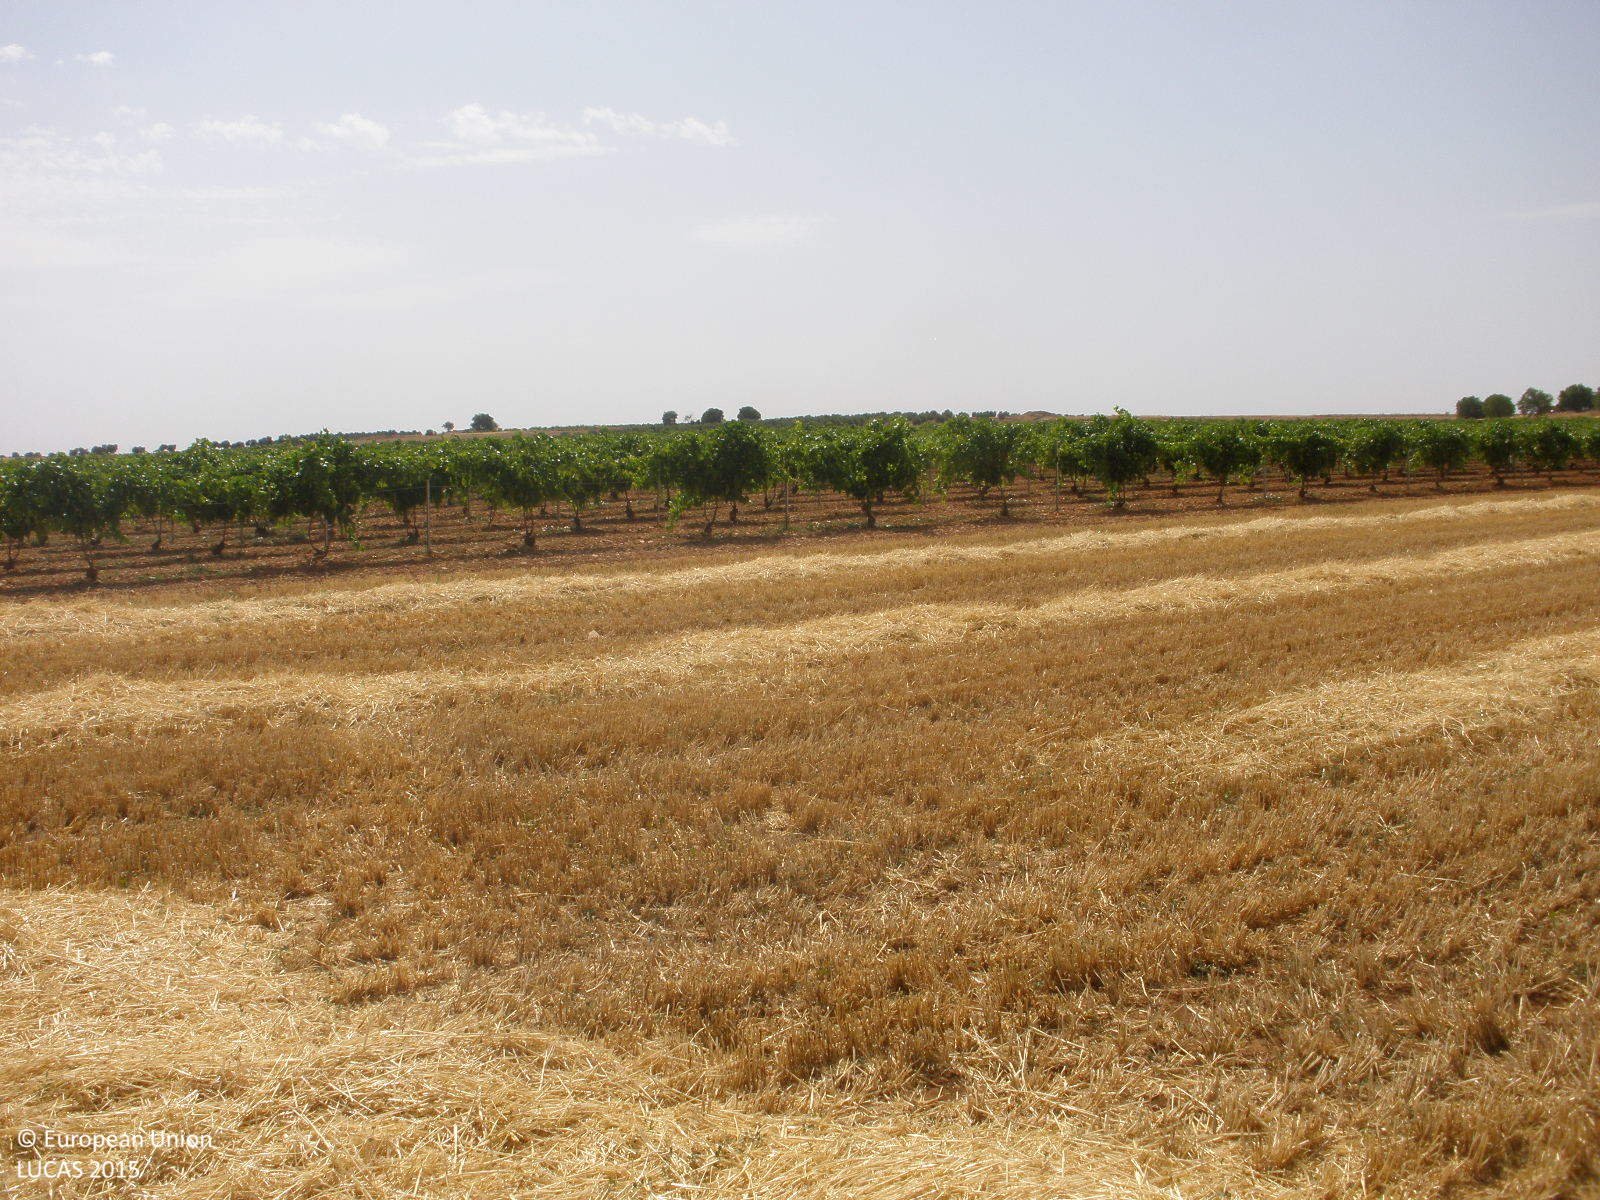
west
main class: Cropland
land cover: Barley
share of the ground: < 10 %
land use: Agriculture (excluding fallow land and kitchen gardens)
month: July
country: ES
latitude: 39.9083
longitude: -3.4211
